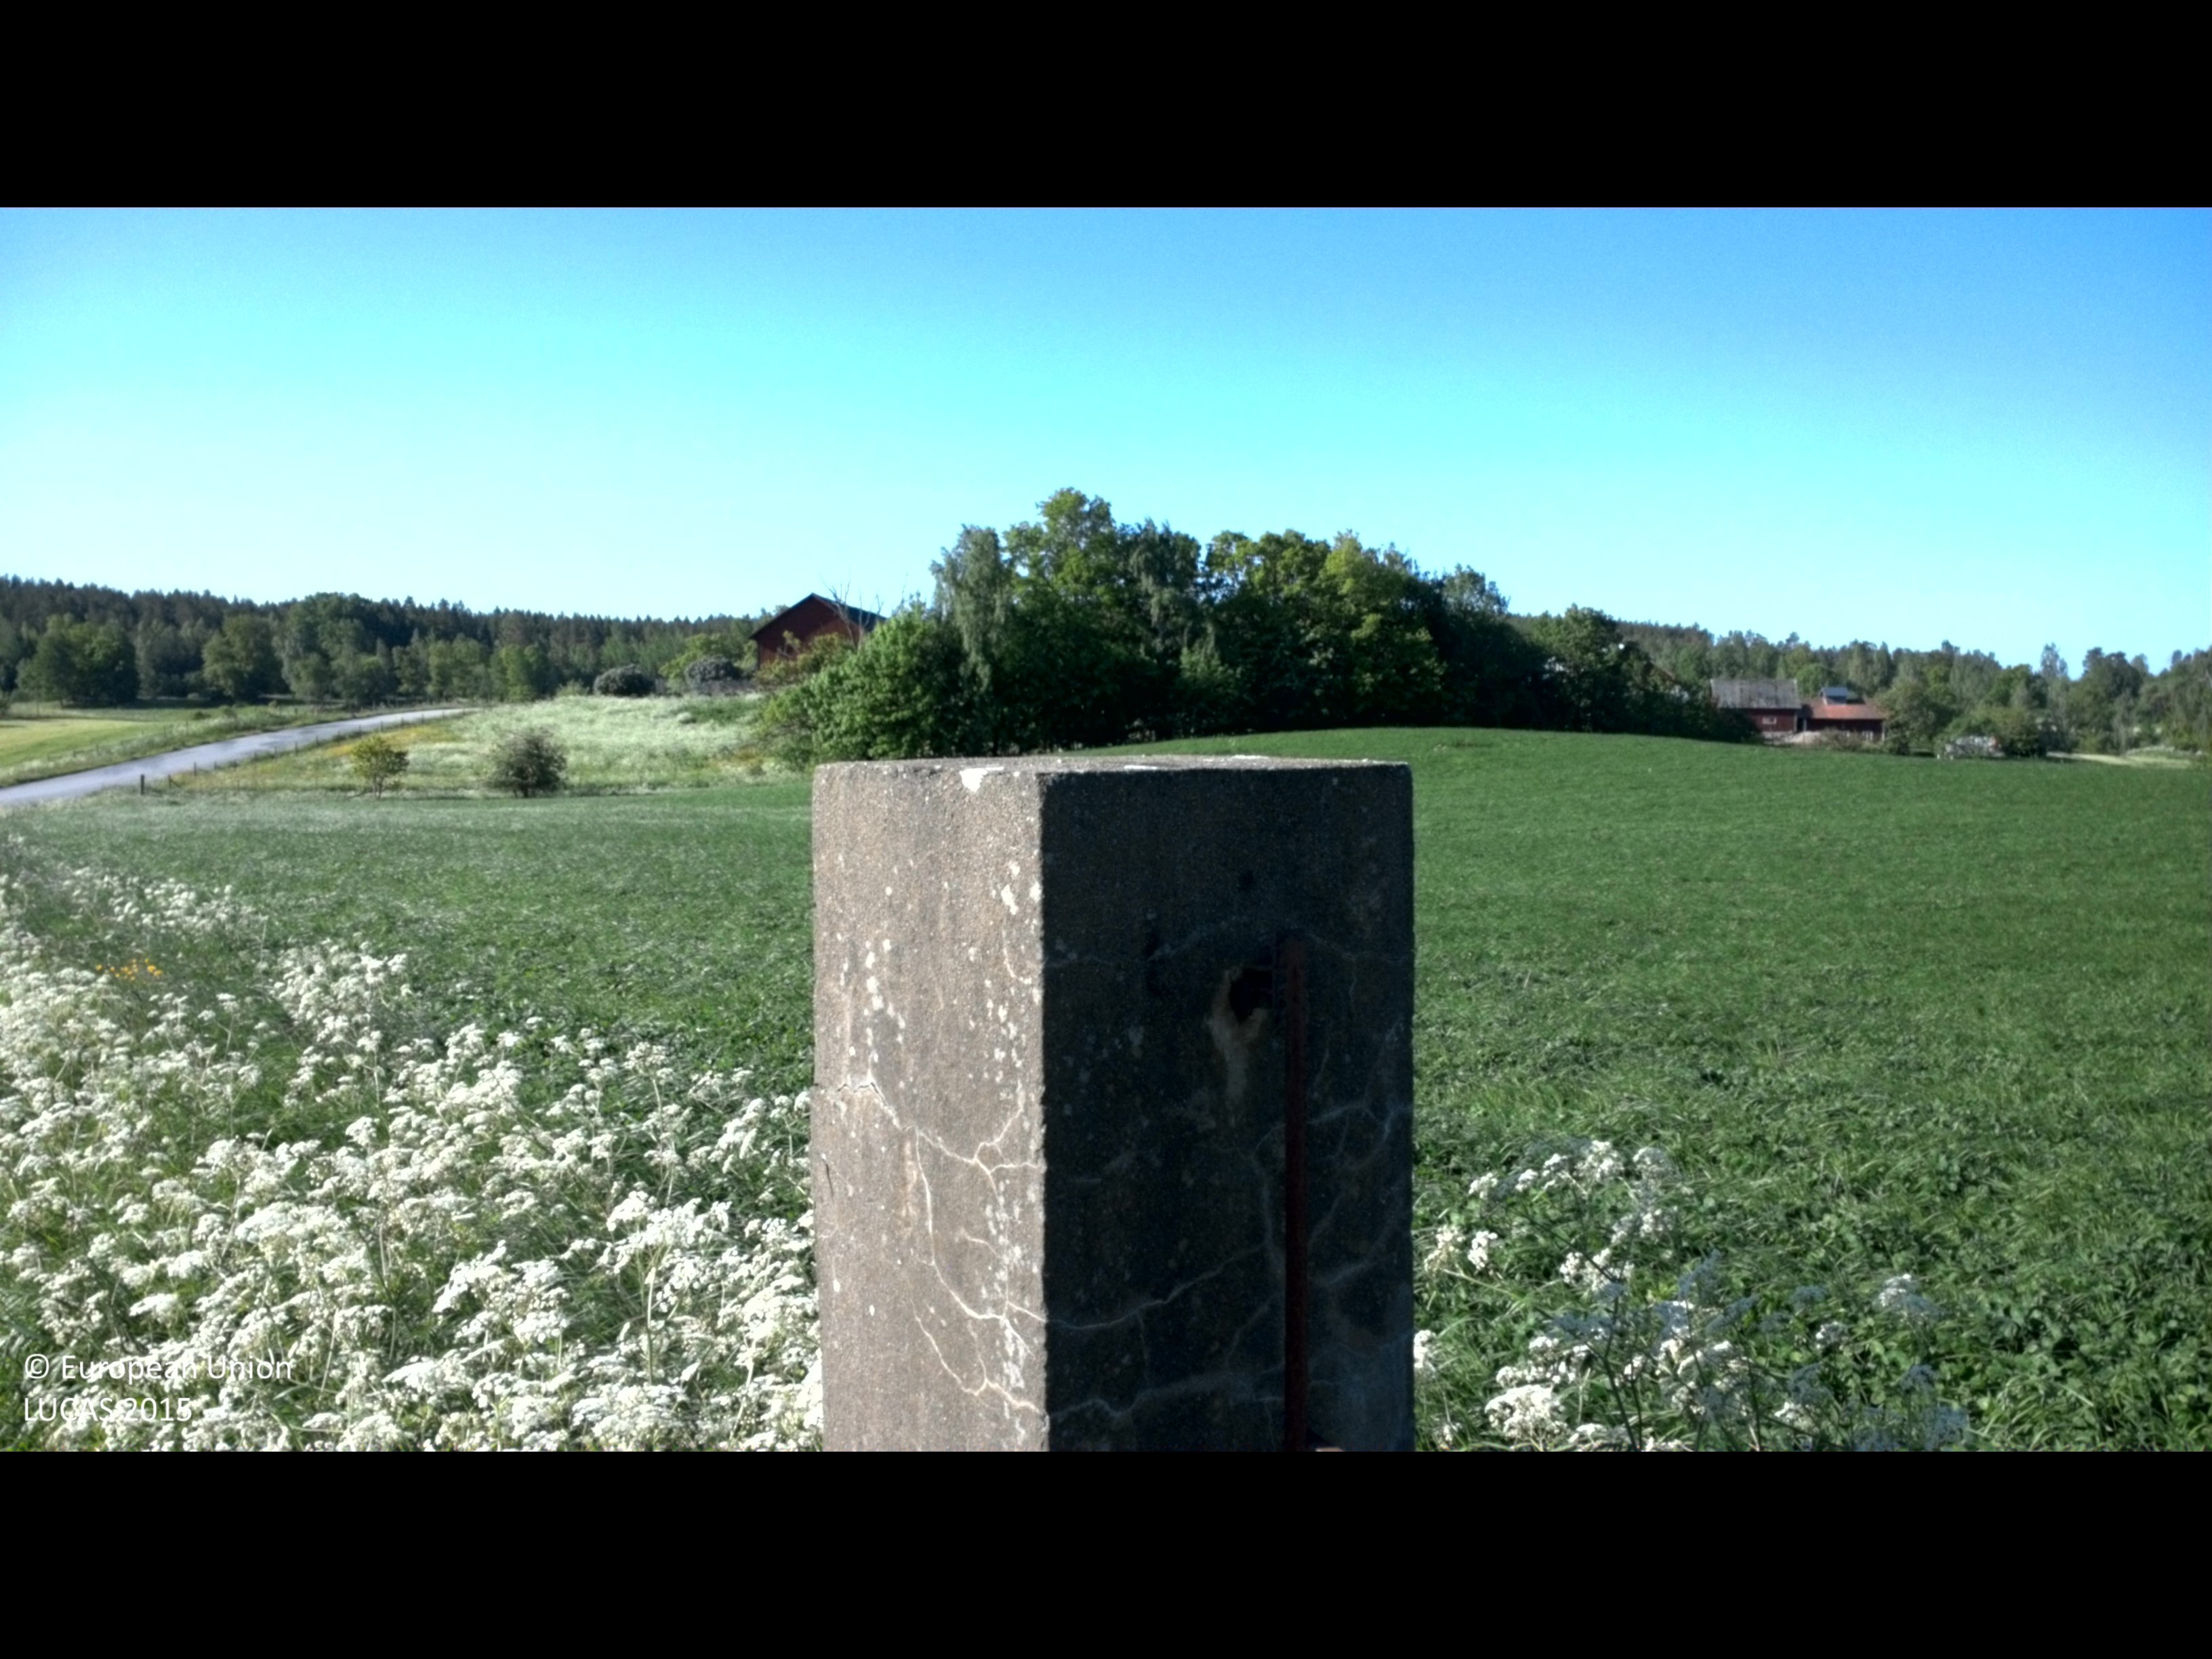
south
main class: Cropland
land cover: Other leguminous and mixtures for fodder
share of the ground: > 75 %
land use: Agriculture (excluding fallow land and kitchen gardens)
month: June
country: SE
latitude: 57.8023
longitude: 16.2740
